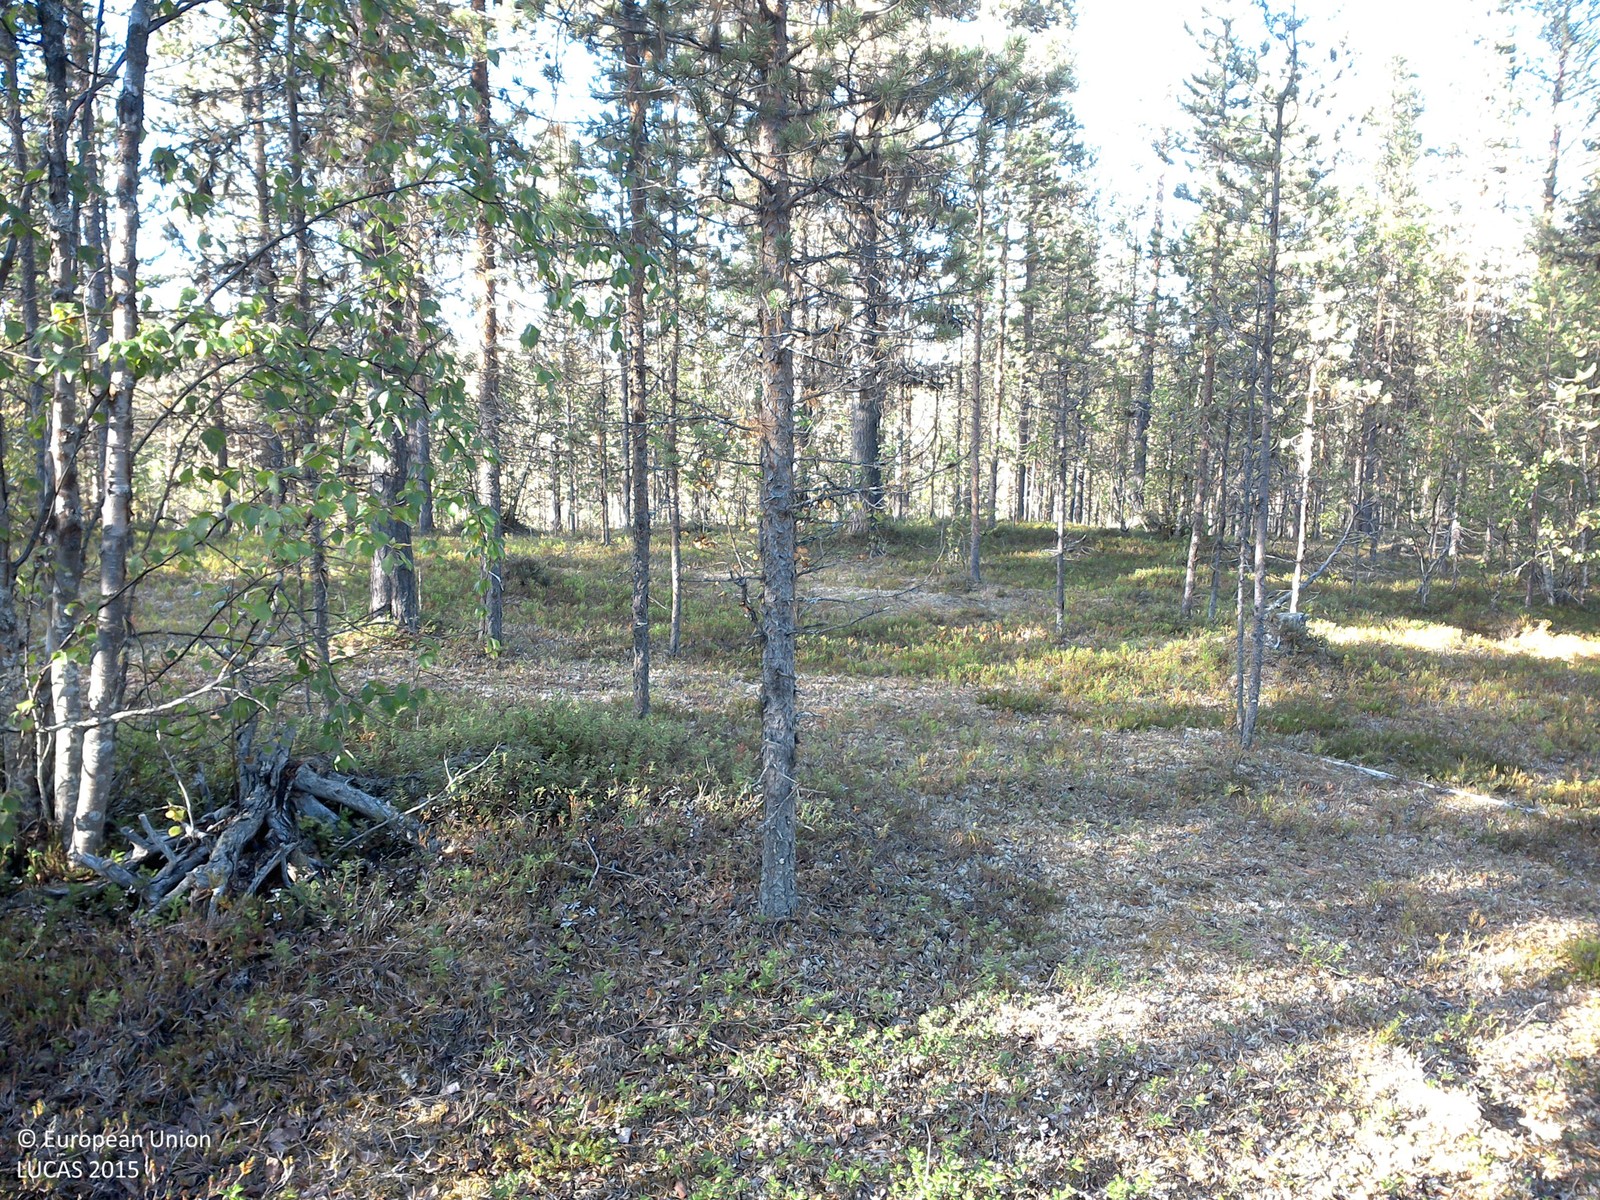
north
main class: Woodland
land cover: Pine dominated mixed woodland
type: boreal forest
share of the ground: 25 - 50 %
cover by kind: shrubs 35 %, lichens and mosses 30 %, coniferous forest trees 25 %, broadleaved forest trees 10 %
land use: Forestry
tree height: > 5 m
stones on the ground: < 10 %
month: August
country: SE
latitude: 68.1245
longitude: 23.0615
